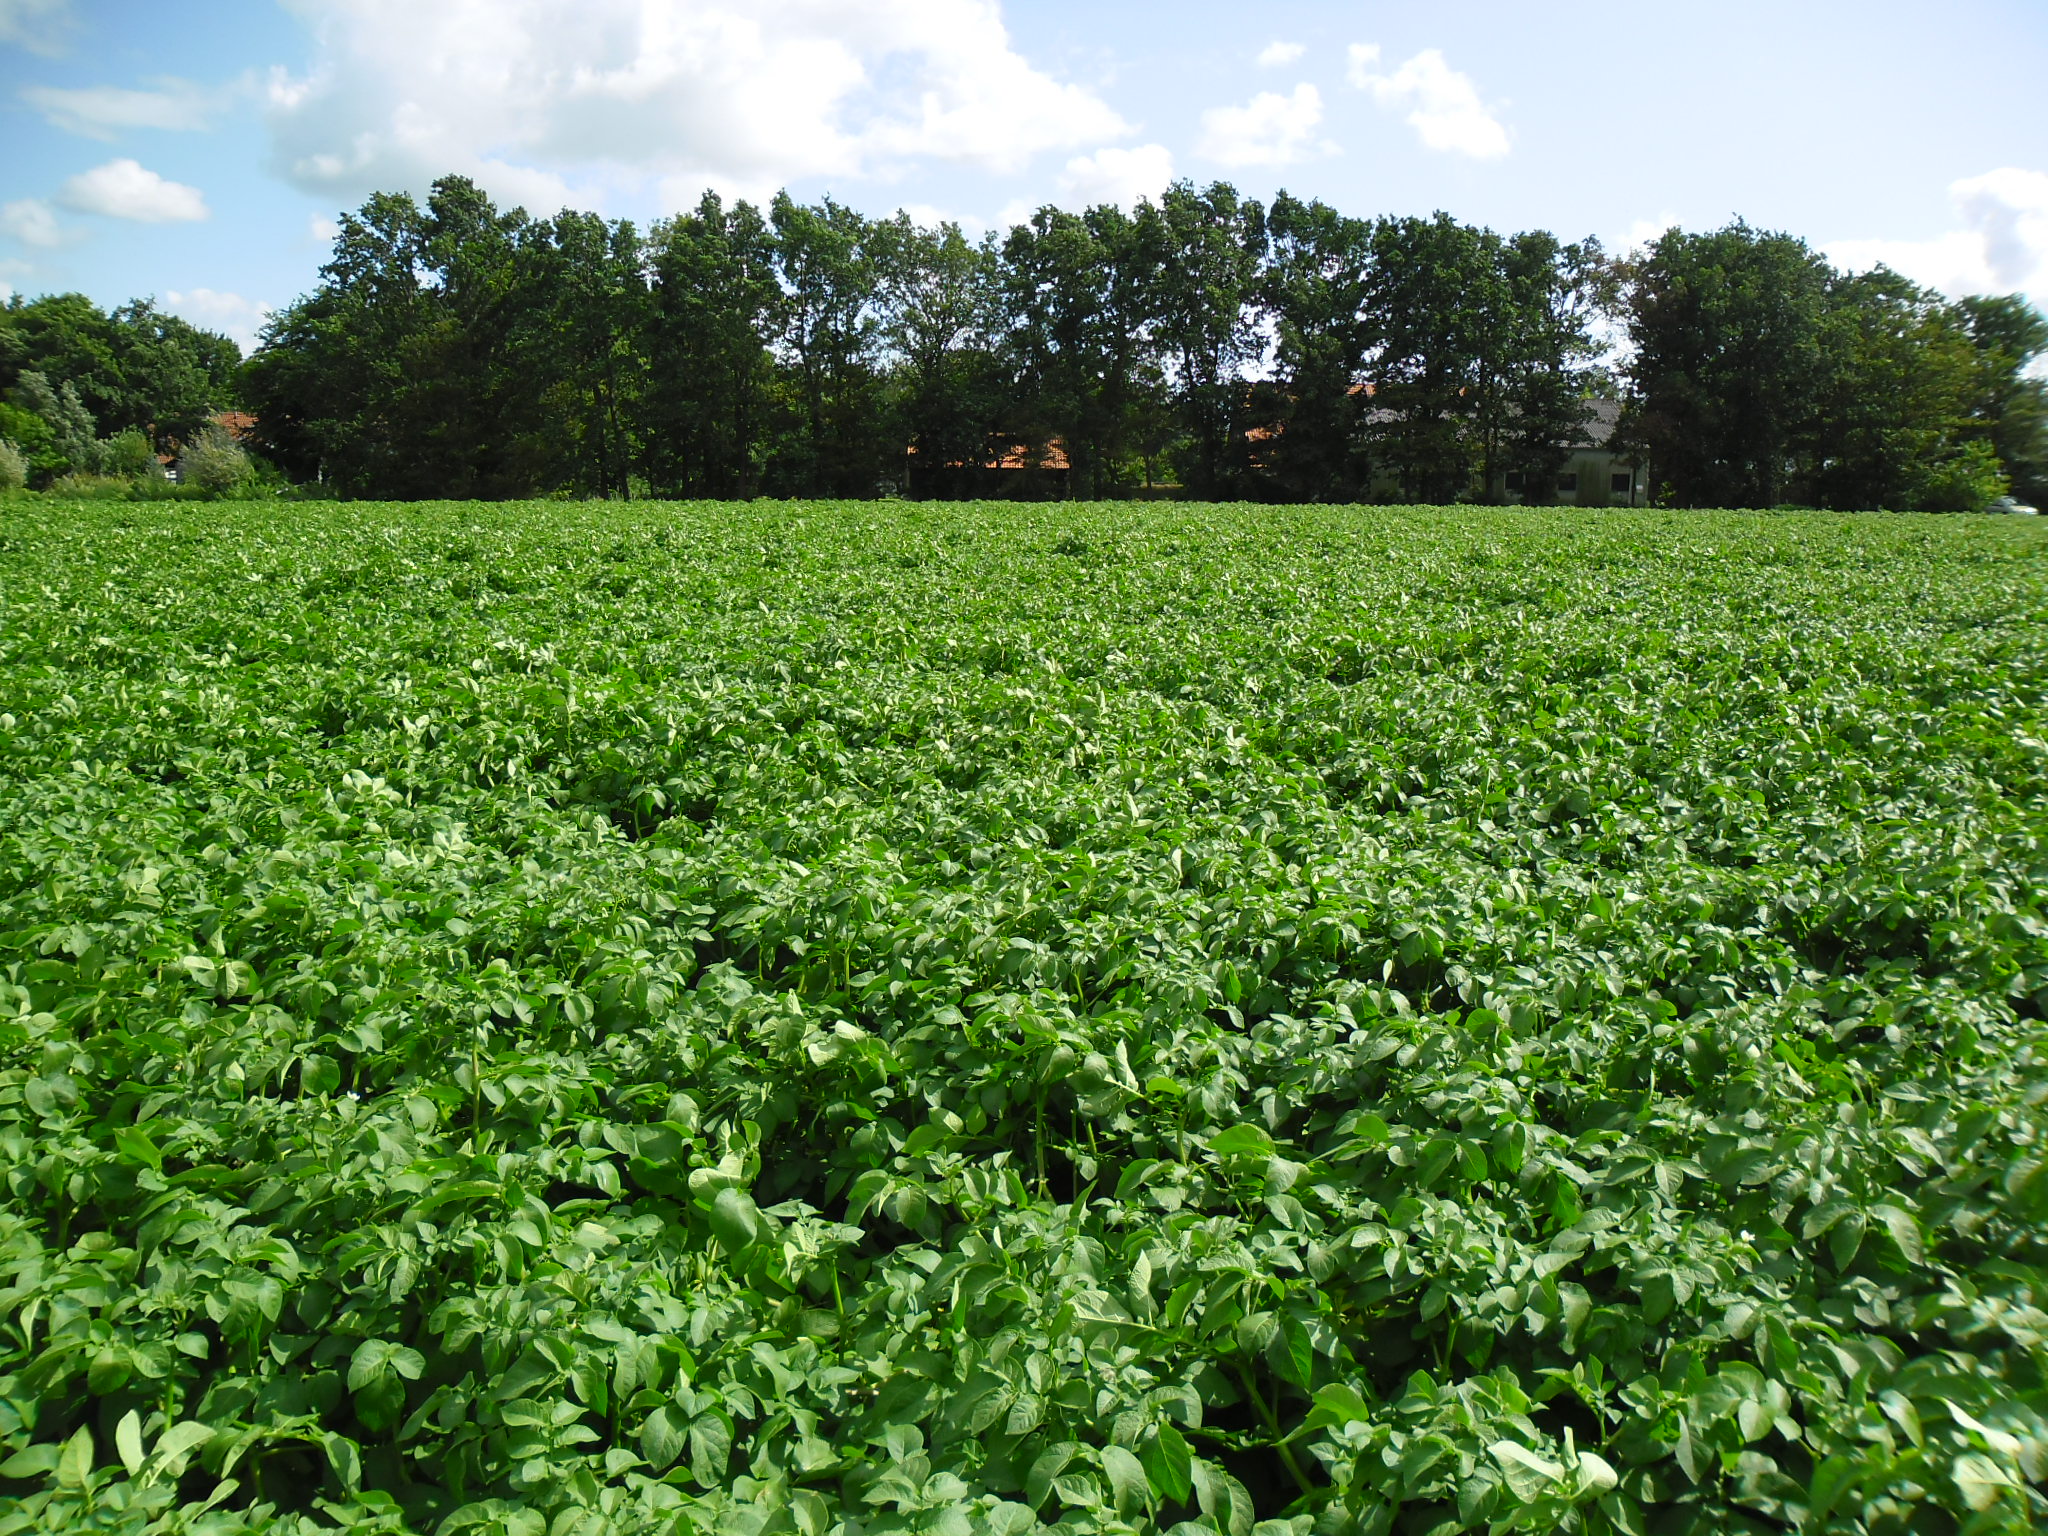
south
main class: Cropland
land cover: Potatoes
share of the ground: > 75 %
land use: Agriculture (excluding fallow land and kitchen gardens)
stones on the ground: < 10 %
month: July
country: NL
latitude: 52.7112
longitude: 5.6322
